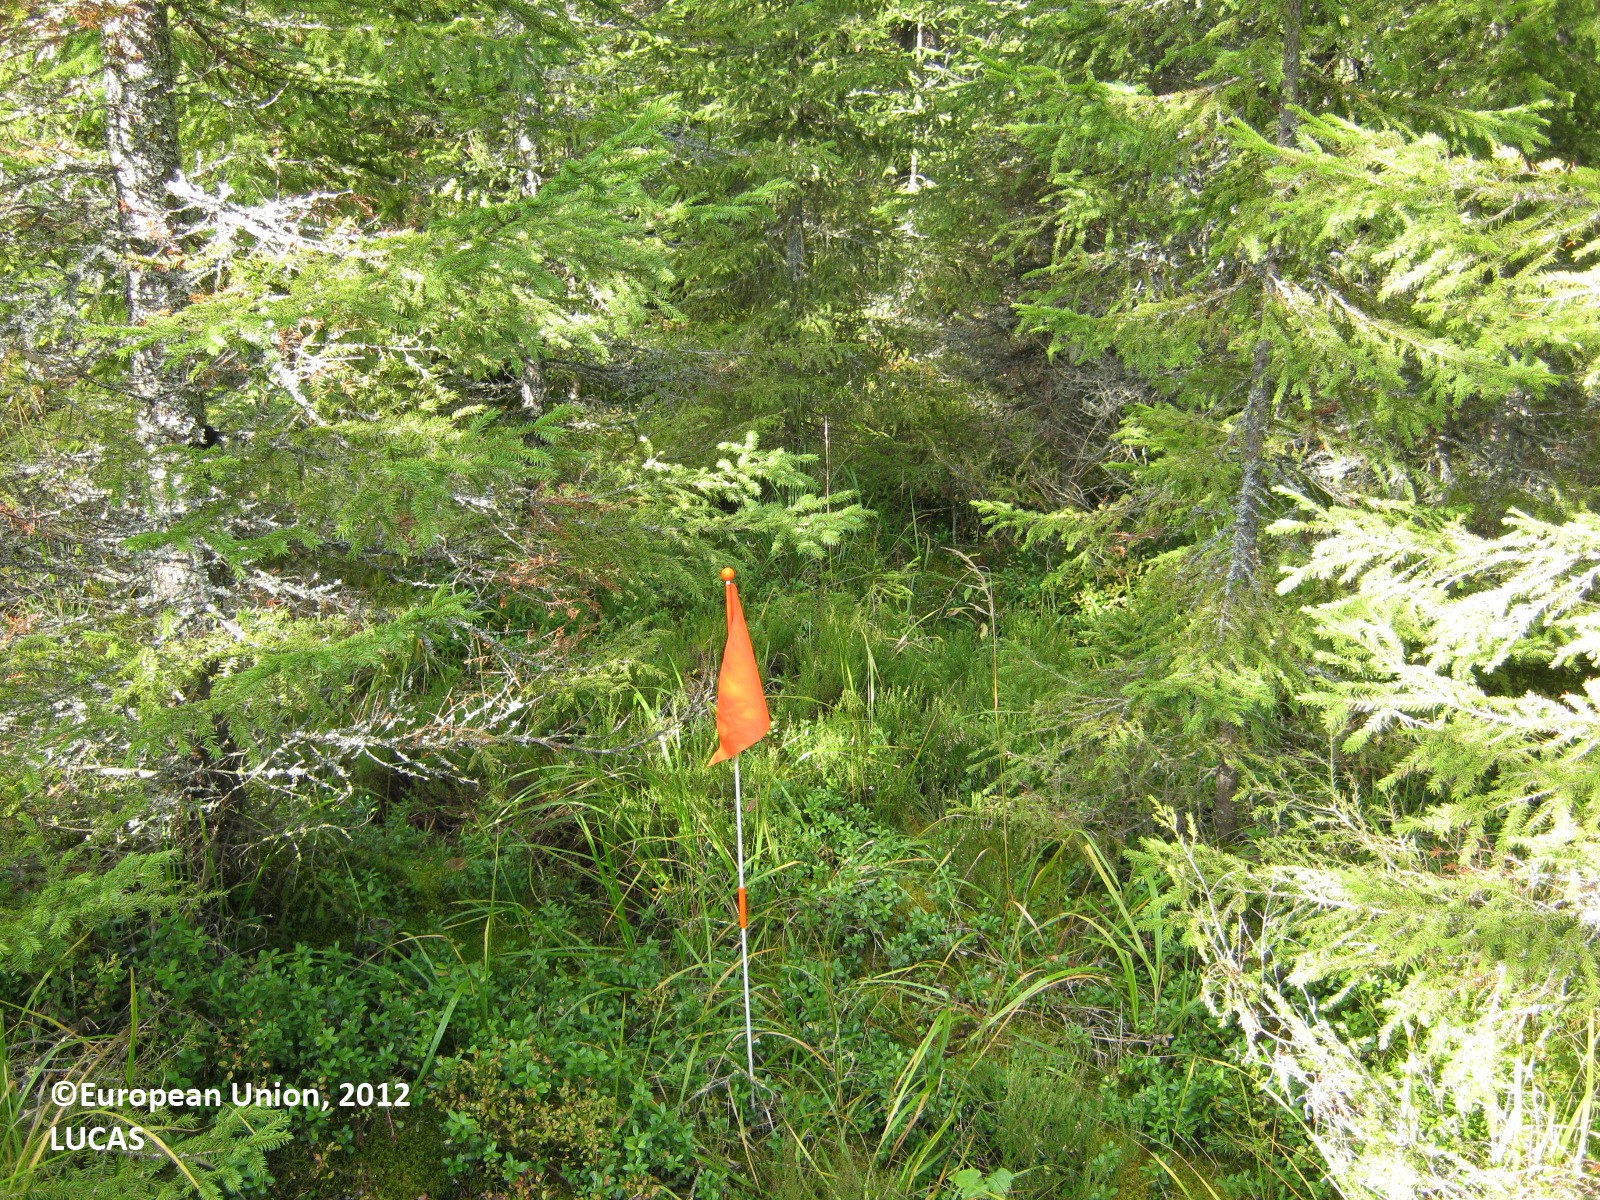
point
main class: Woodland
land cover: Spruce dominated coniferous woodland
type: boreal forest
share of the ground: > 75 %
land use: Forestry
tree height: > 5 m
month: September
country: FI
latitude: 62.2526
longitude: 28.9143
